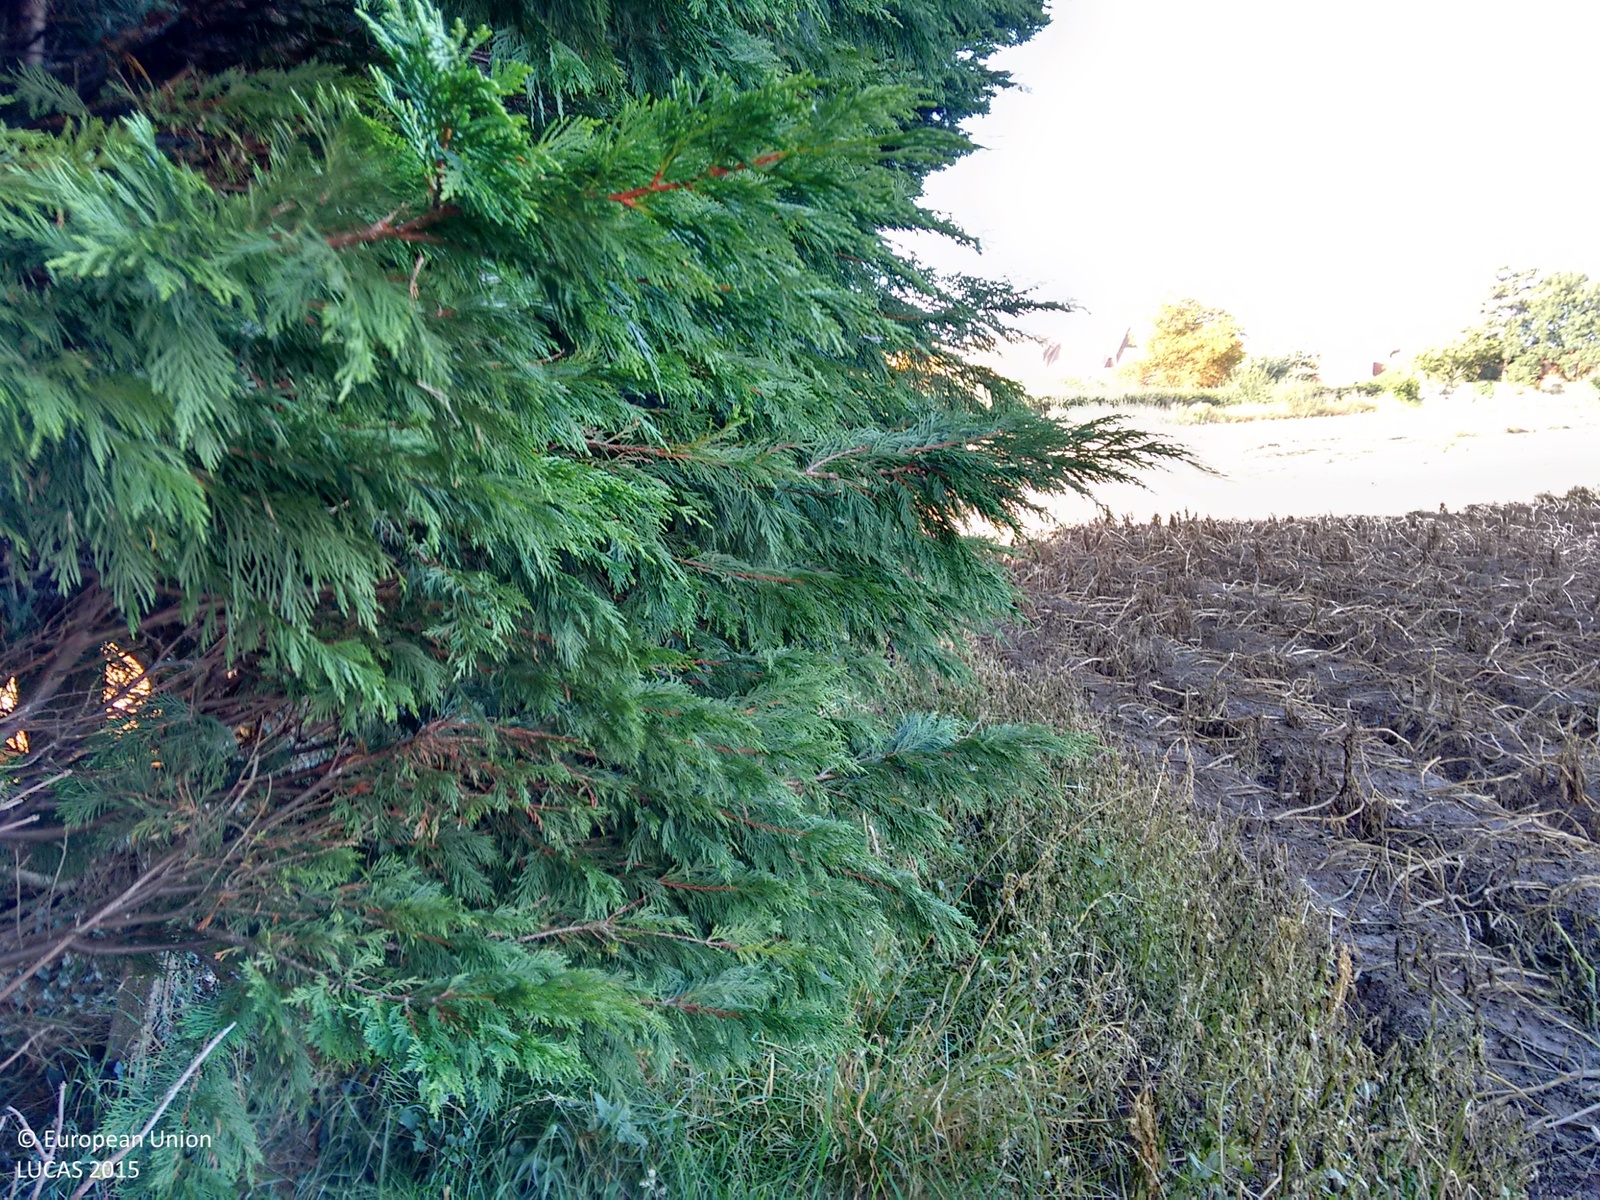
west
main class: Cropland
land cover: Common wheat
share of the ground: > 75 %
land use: Agriculture (excluding fallow land and kitchen gardens)
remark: Harvested field
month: October
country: GB
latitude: 52.6997
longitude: 1.6807
